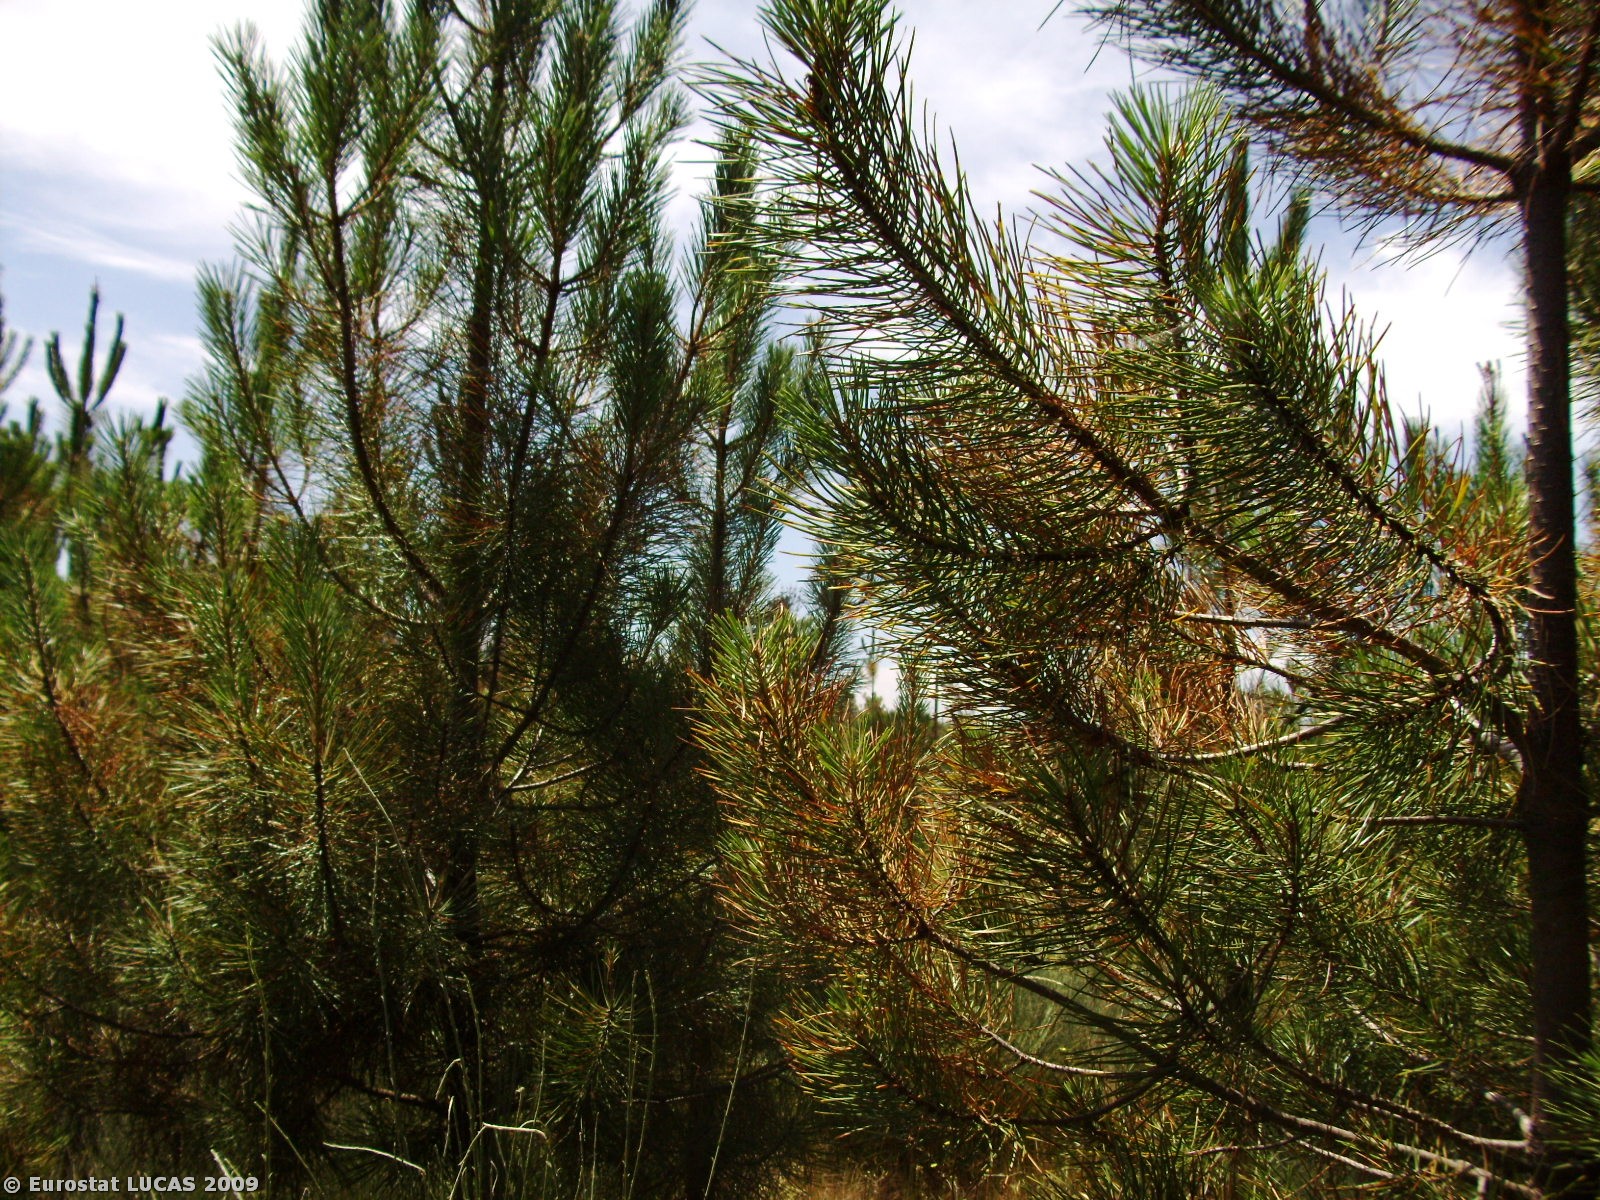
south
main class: Woodland
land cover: Coniferous woodland
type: coniferous forest of the mediterranean region
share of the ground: > 75 %
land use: Forestry
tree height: > 5 m
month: July
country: PT
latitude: 40.8871
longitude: -7.7483
